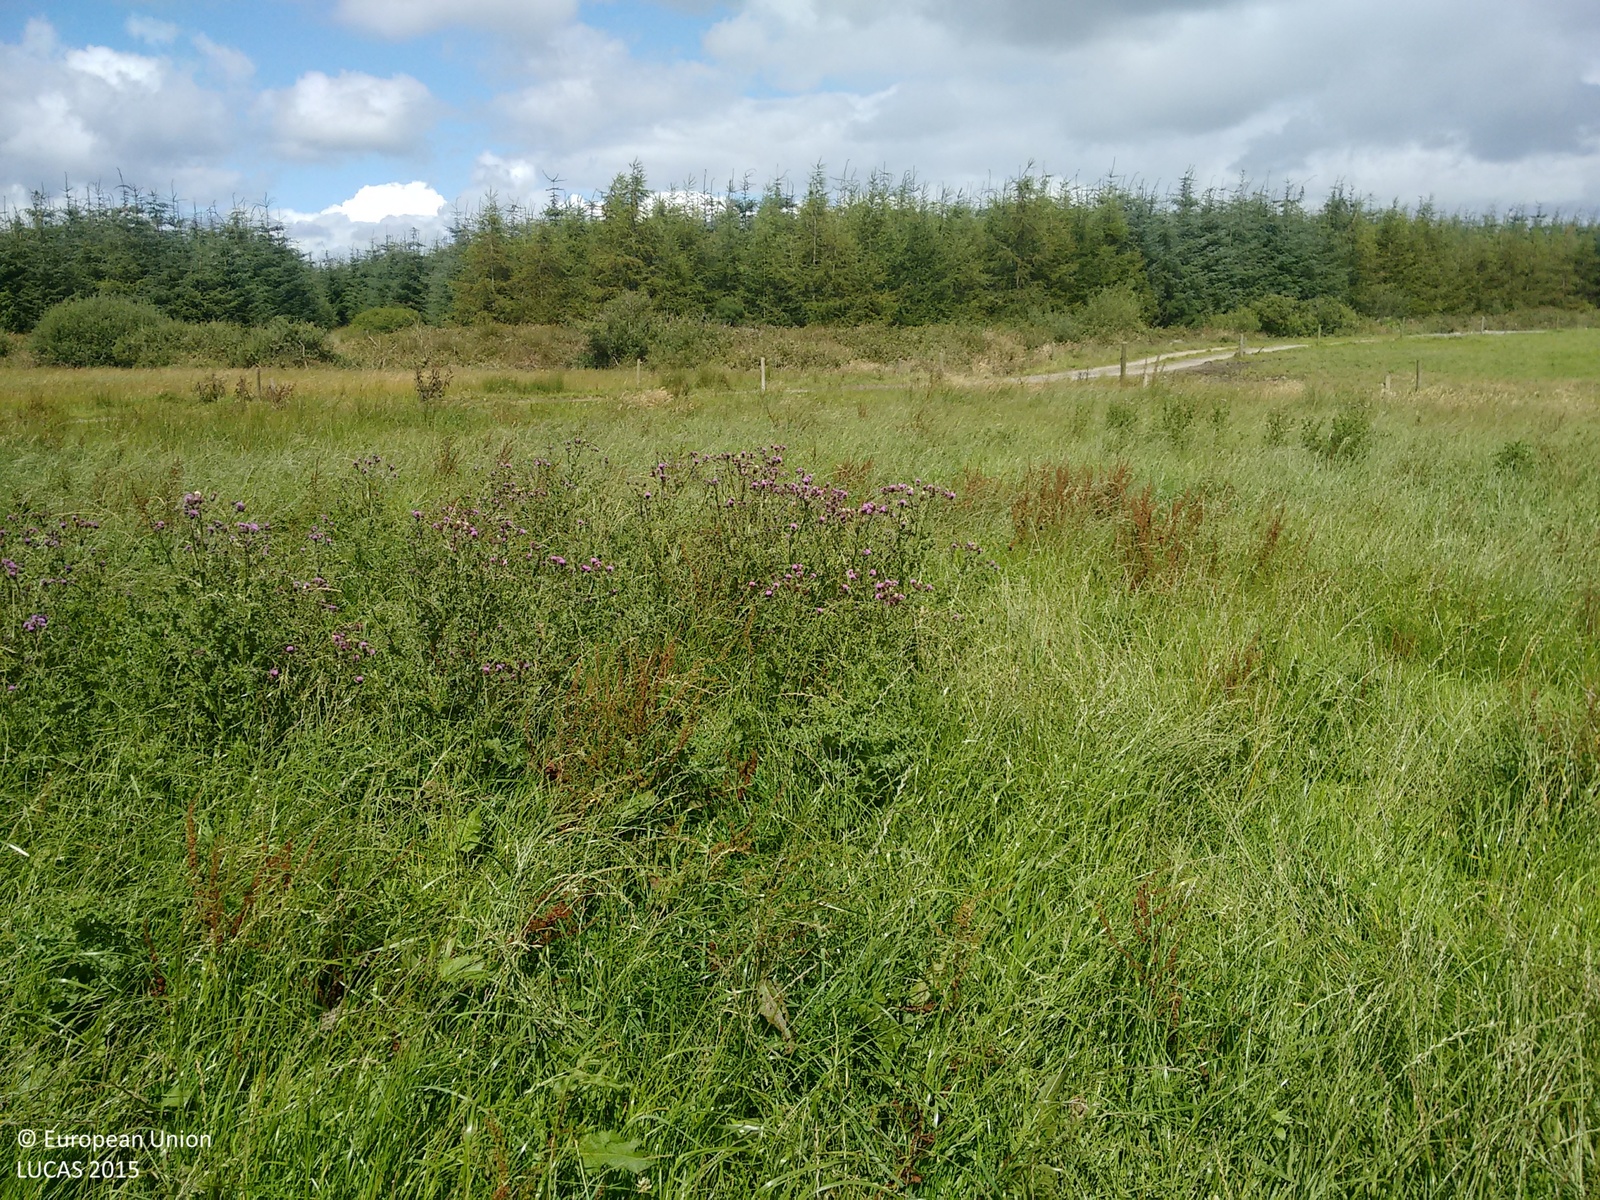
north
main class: Grassland
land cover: Grassland without tree/shrub cover
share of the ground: > 75 %
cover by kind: herbaceous plants 100 %
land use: Agriculture (excluding fallow land and kitchen gardens)
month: July
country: IE
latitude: 51.6278
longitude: -9.1578
